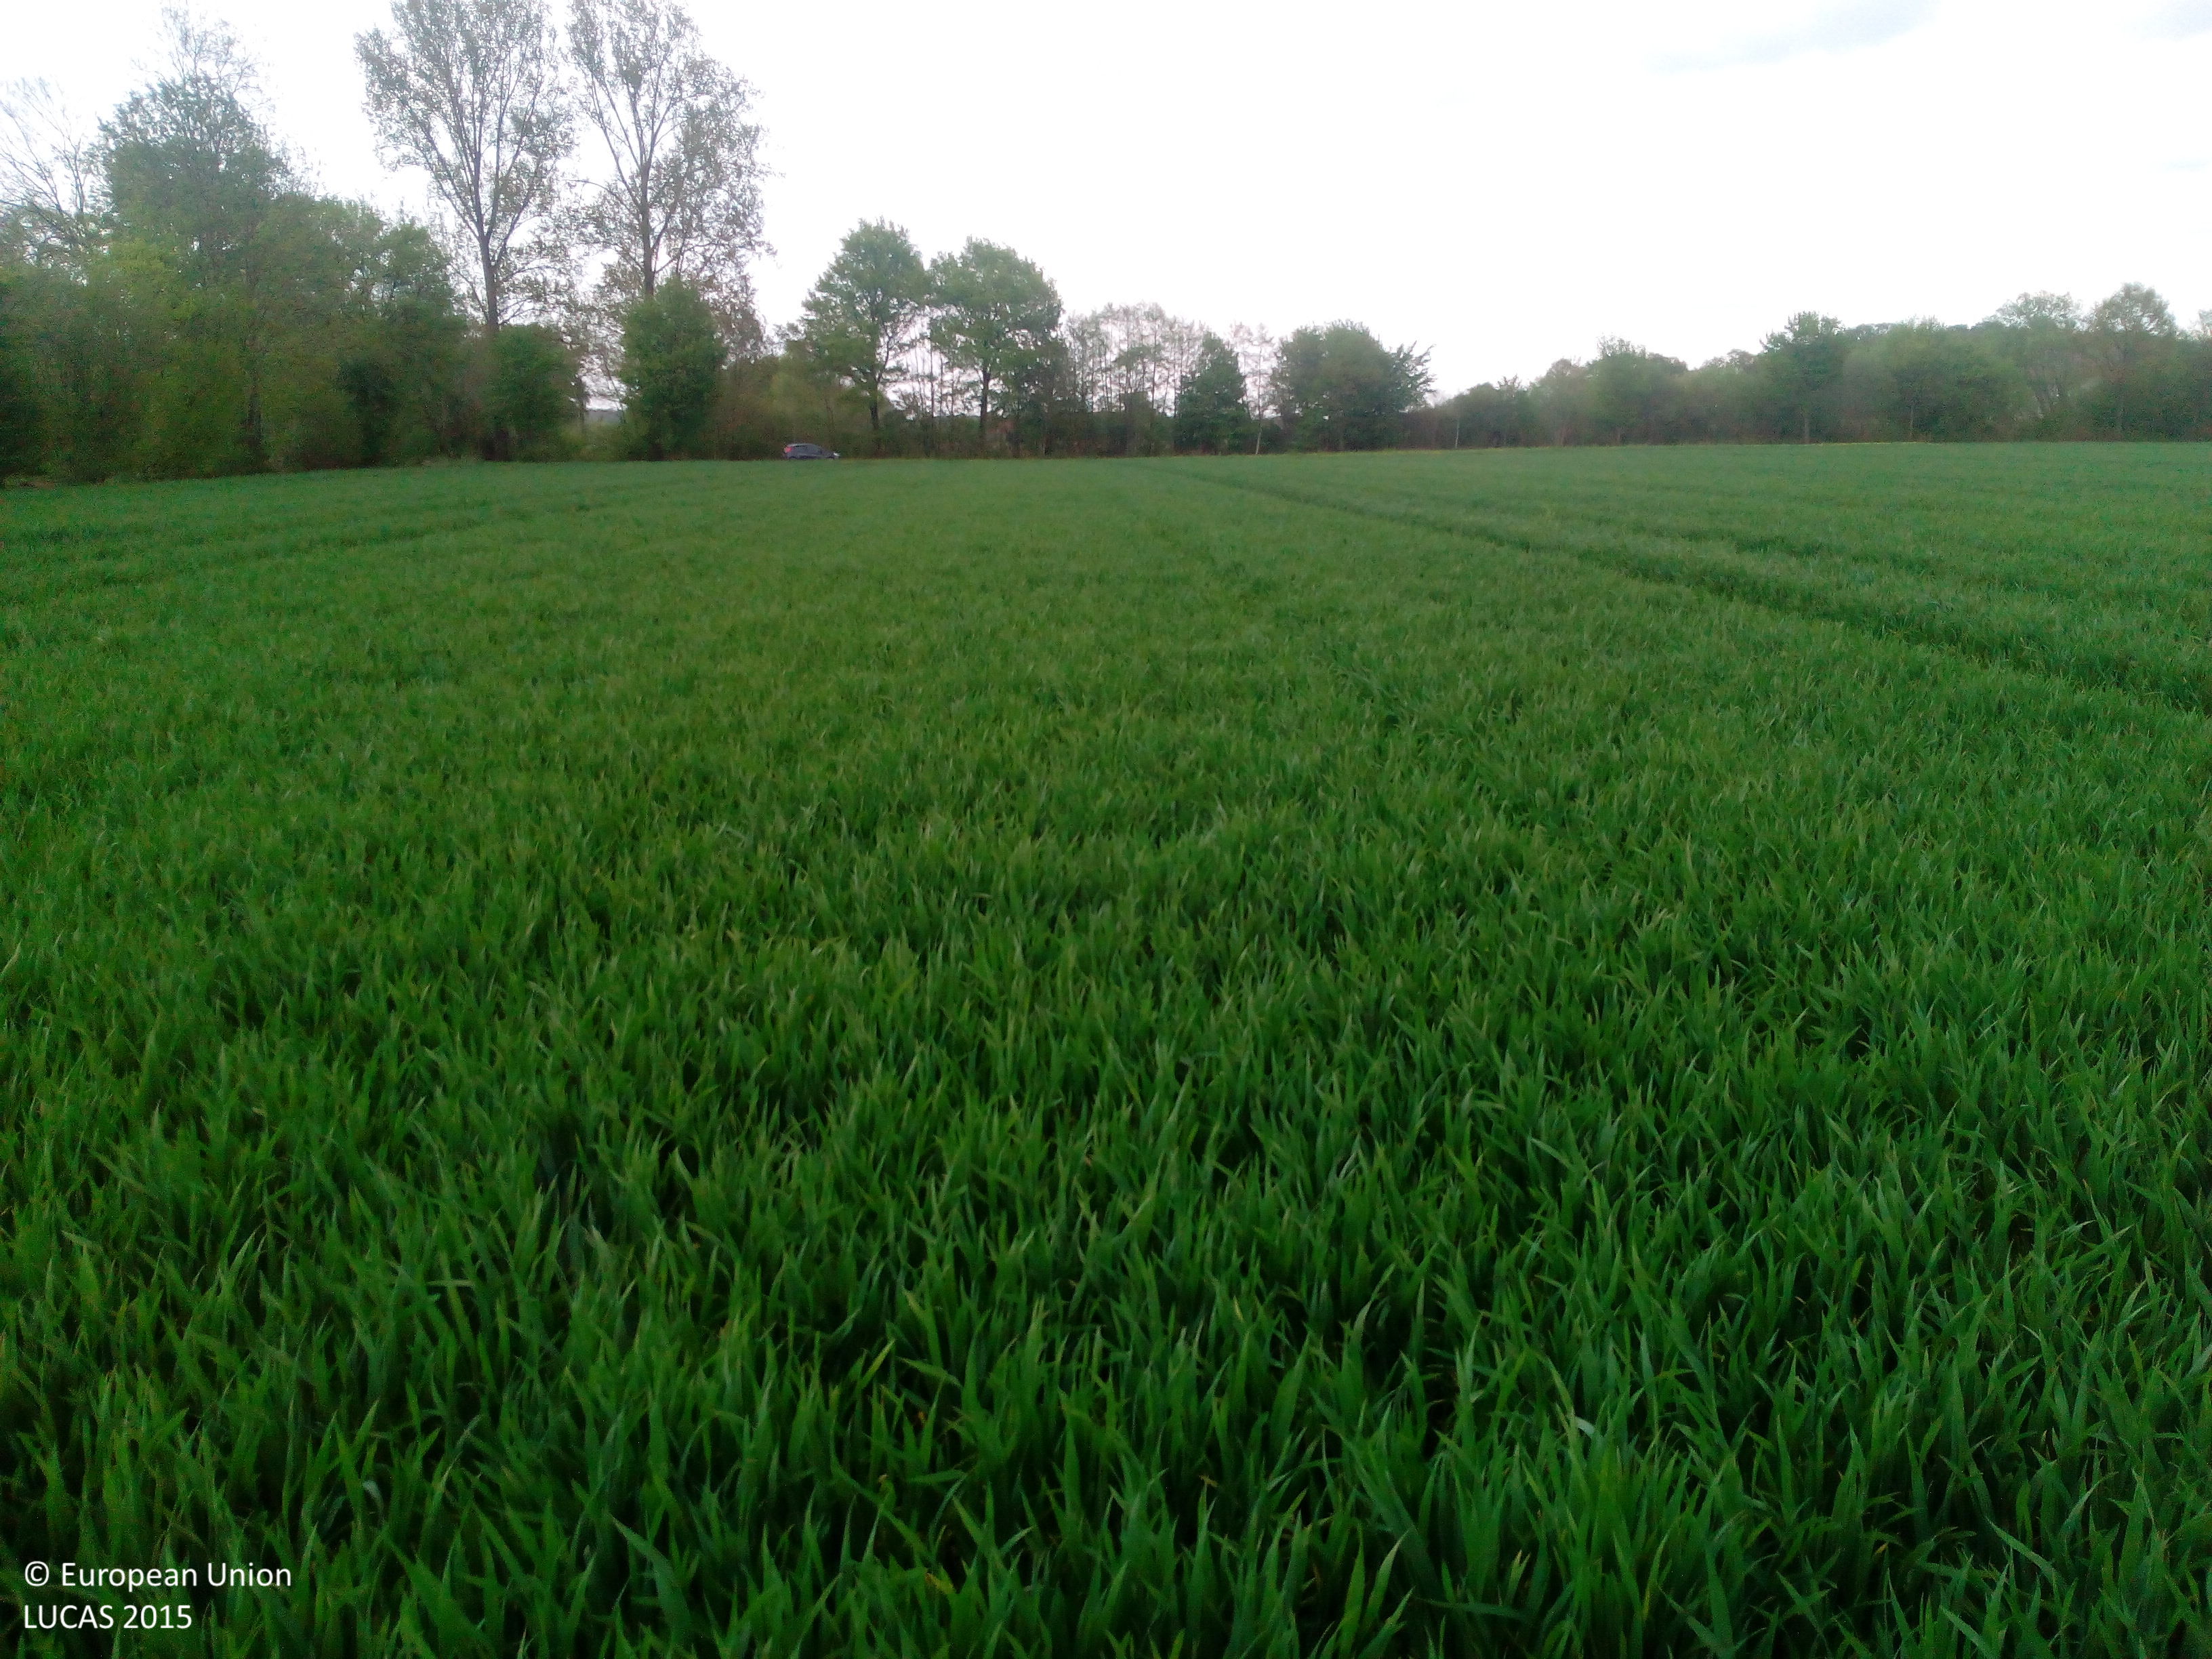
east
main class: Cropland
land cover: Triticale
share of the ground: > 75 %
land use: Agriculture (excluding fallow land and kitchen gardens)
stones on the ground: < 10 %
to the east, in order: Triticale; Grassland without tree/shrub cover; Tracks; Grass margins; Broadleaved woodland; Ditches and canals; Single bushes/trees; Maize
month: May
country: DE
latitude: 51.8635
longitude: 7.4009
